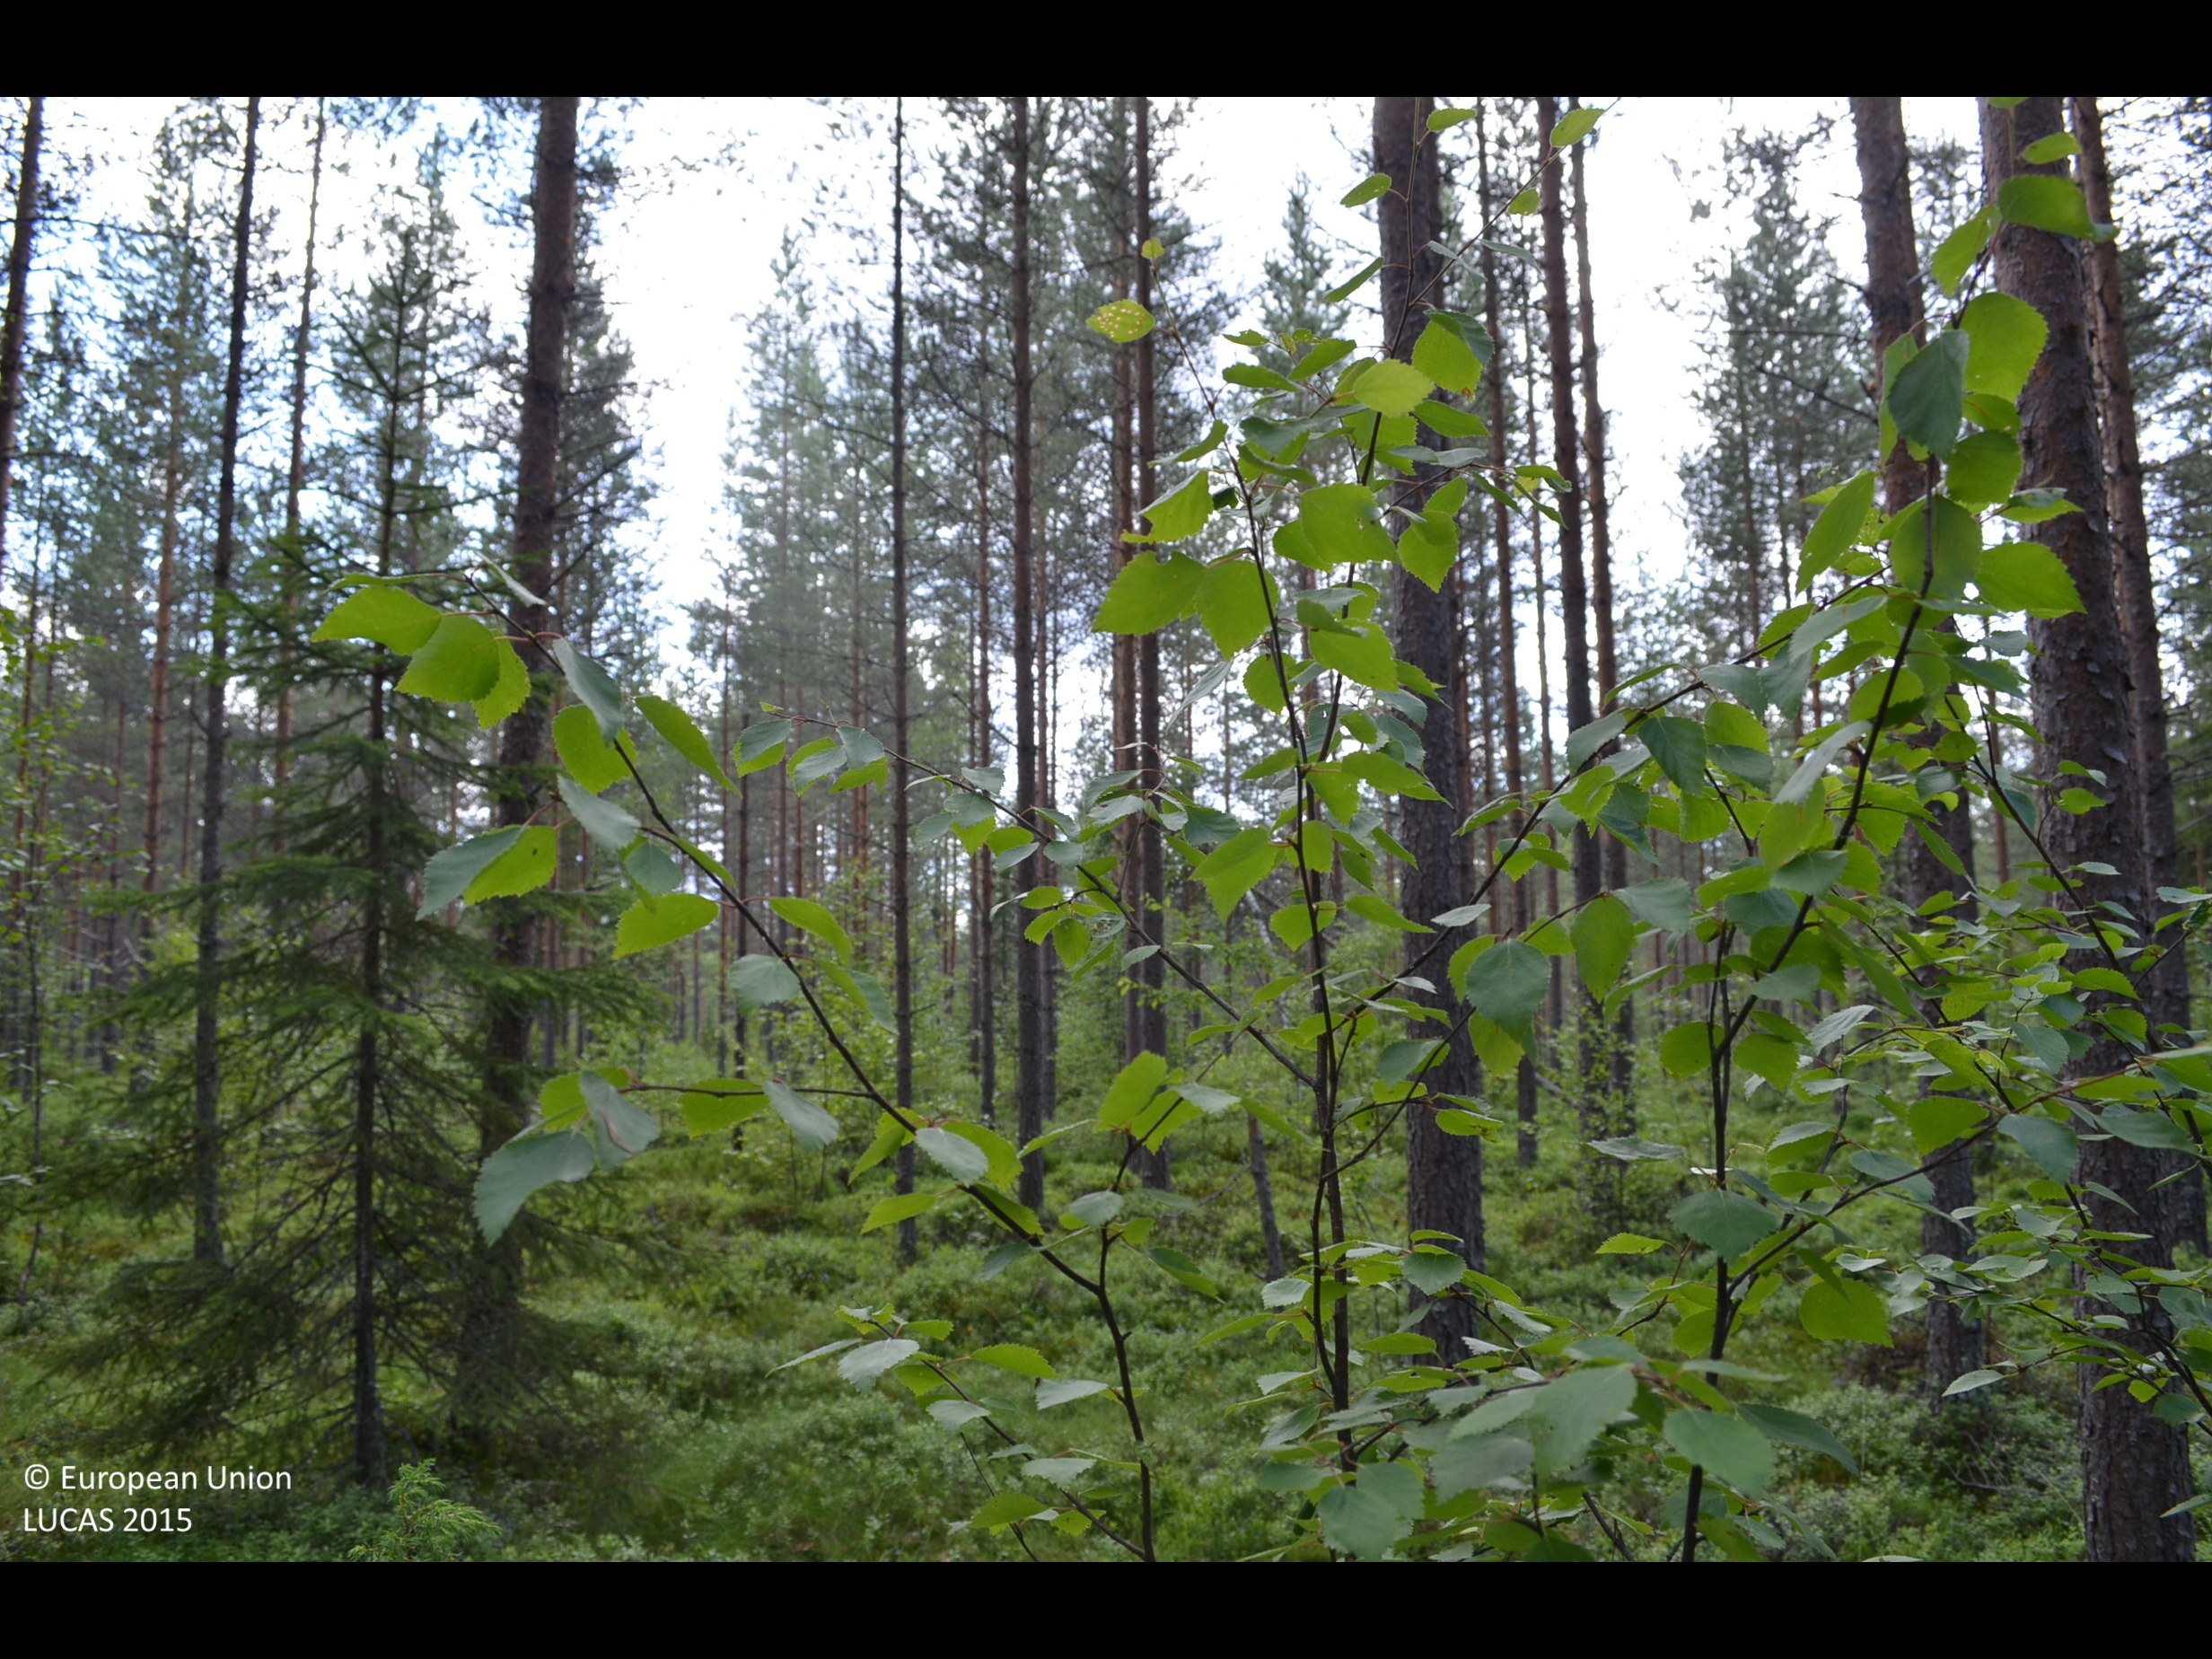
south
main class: Woodland
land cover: Pine dominated coniferous woodland
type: boreal forest
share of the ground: > 75 %
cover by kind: coniferous forest trees 70 %, shrubs 25 %, broadleaved forest trees 5 %
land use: Forestry
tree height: > 5 m
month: July
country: FI
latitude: 62.1208
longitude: 23.5906
